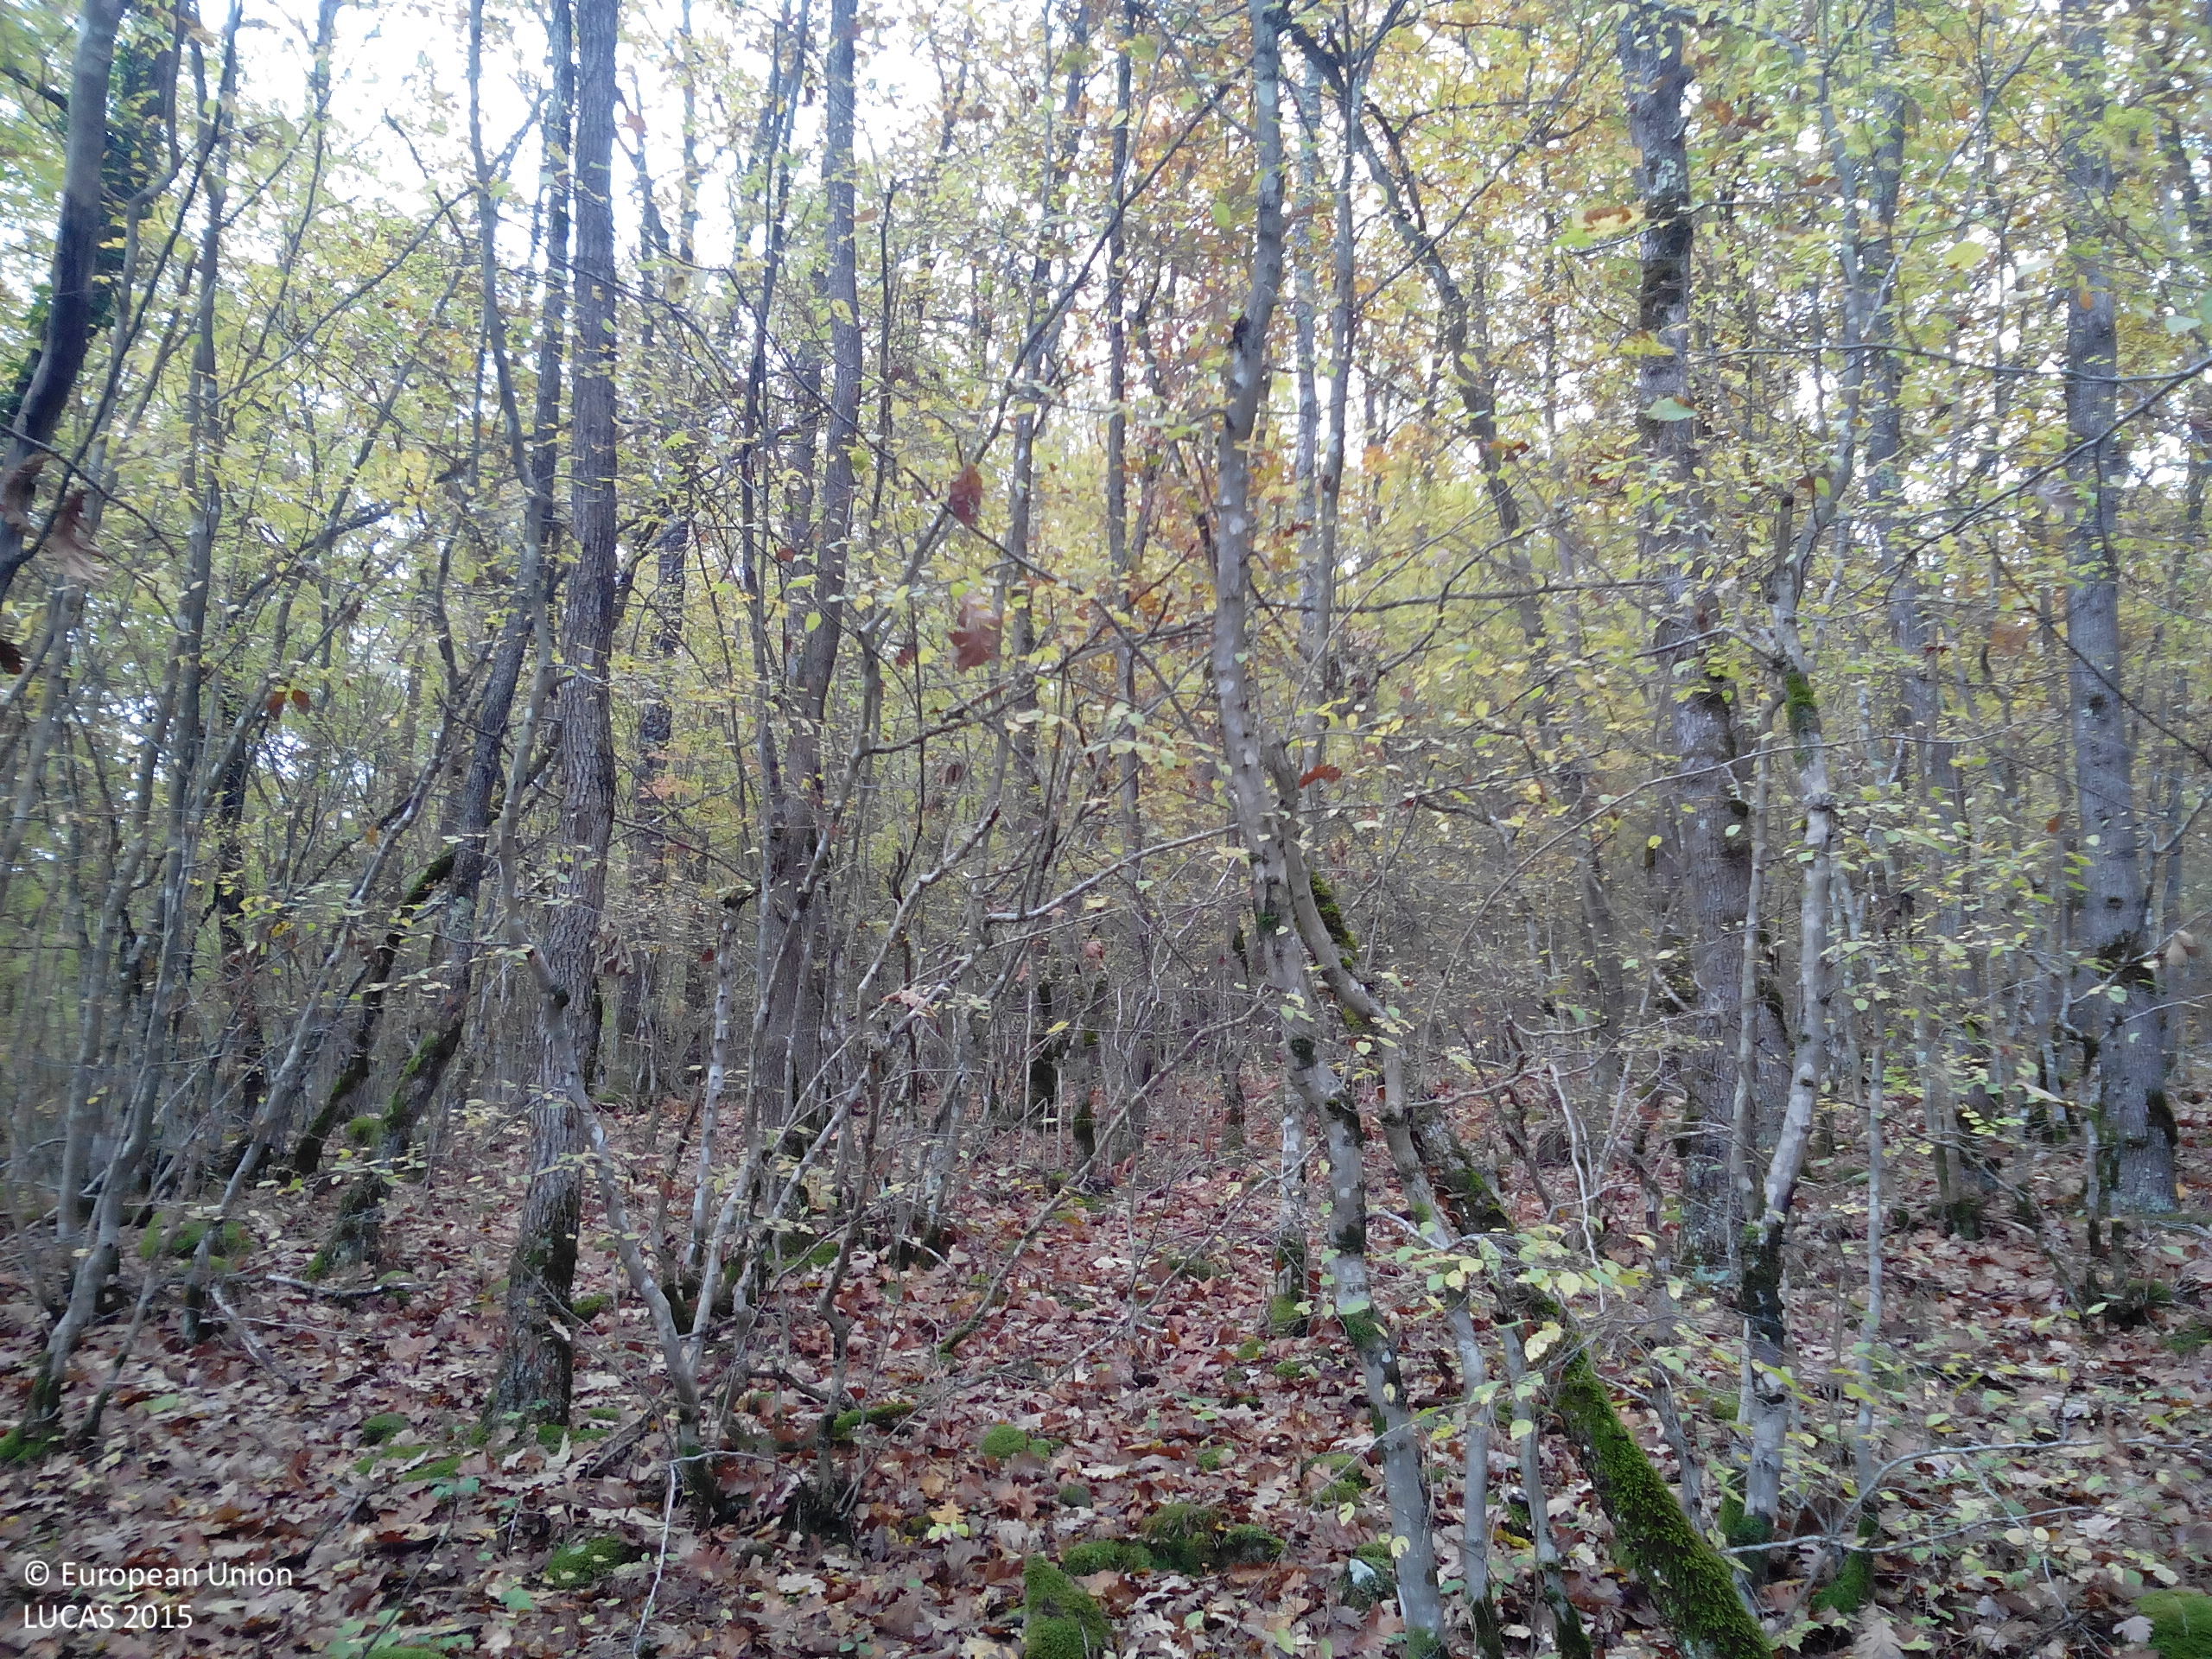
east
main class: Woodland
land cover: Broadleaved woodland
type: mesophytic deciduous forest
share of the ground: > 75 %
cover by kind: broadleaved forest trees 100 %
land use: Forestry
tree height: > 5 m
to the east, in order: Broadleaved woodland
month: October
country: BG
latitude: 43.0322
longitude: 23.8530
